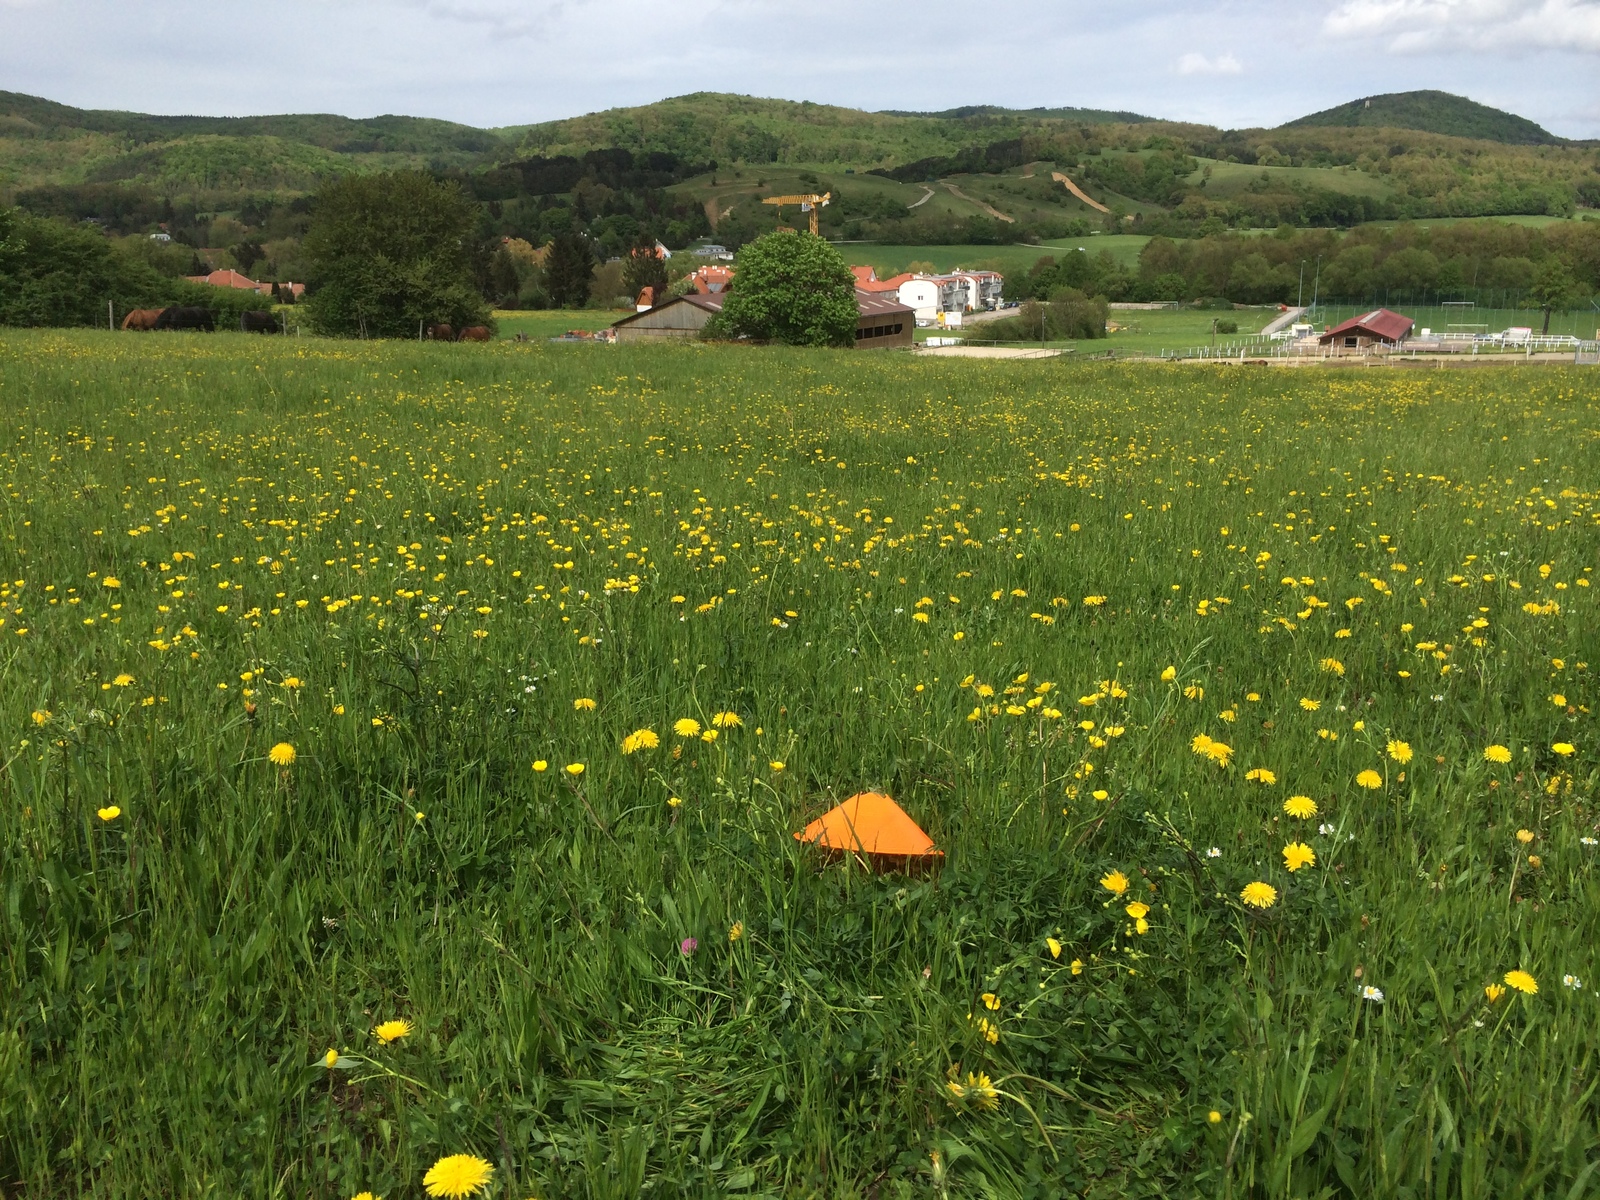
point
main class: Grassland
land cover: Grassland without tree/shrub cover
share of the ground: > 75 %
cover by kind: herbaceous plants 100 %
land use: Agriculture (excluding fallow land and kitchen gardens)
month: May
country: AT
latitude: 48.0691
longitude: 16.1640
